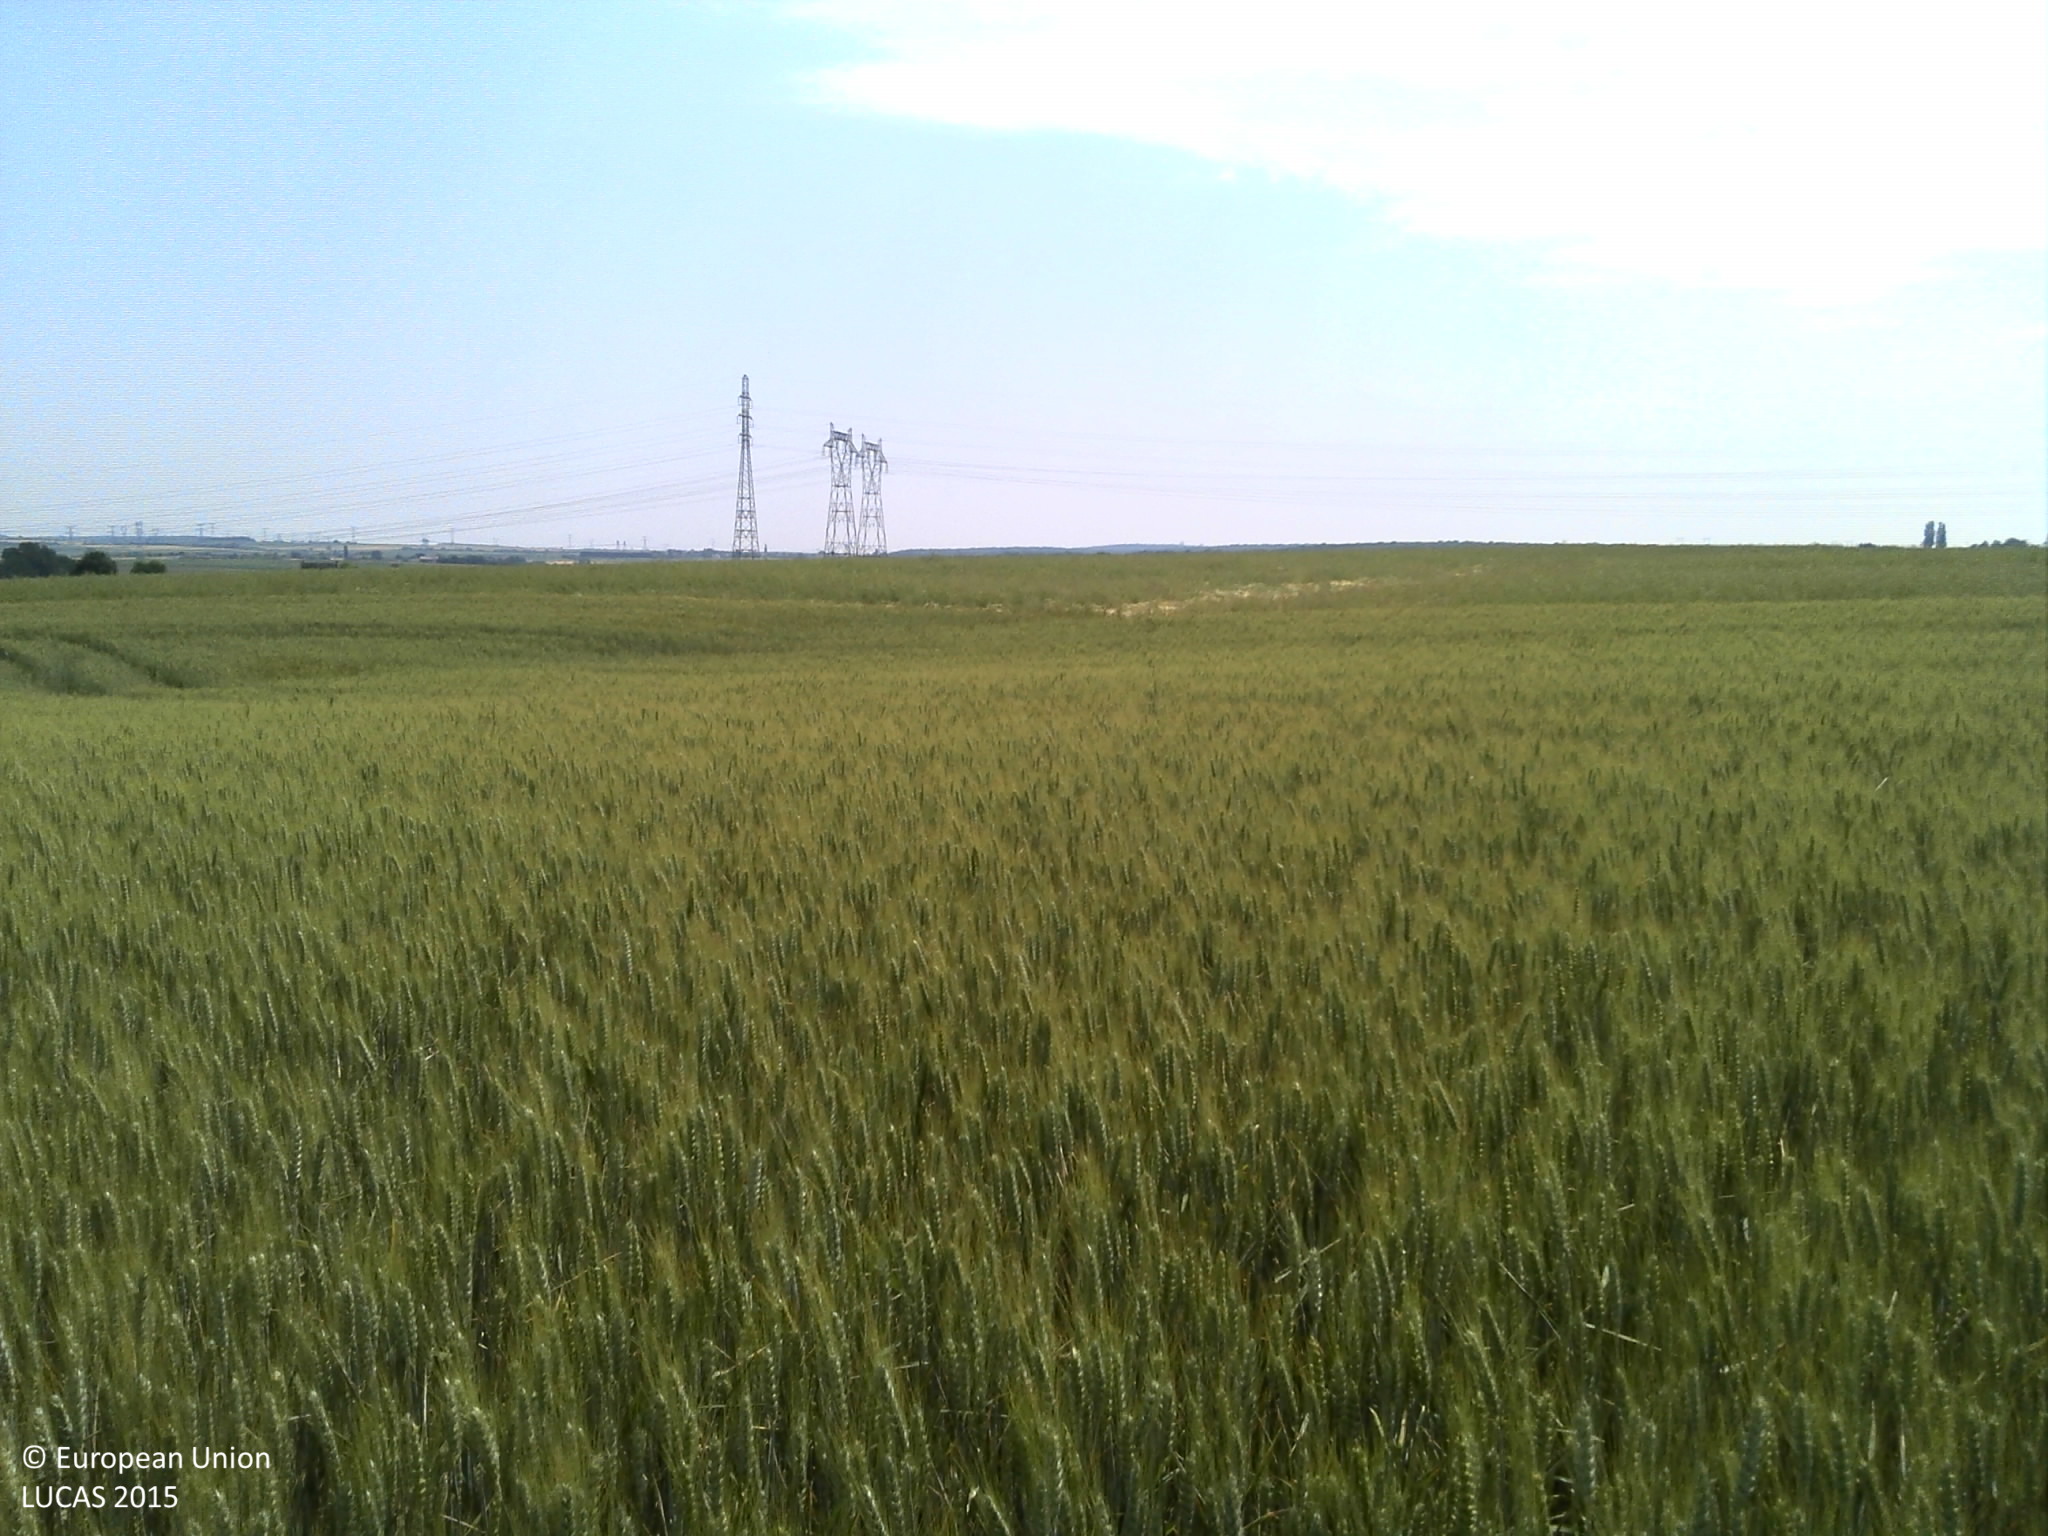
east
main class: Cropland
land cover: Common wheat
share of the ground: > 75 %
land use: Agriculture (excluding fallow land and kitchen gardens)
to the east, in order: Common wheat; Grass margins; Rape and turnip rape; Common wheat
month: June
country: FR
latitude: 49.1856
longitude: 6.2267
